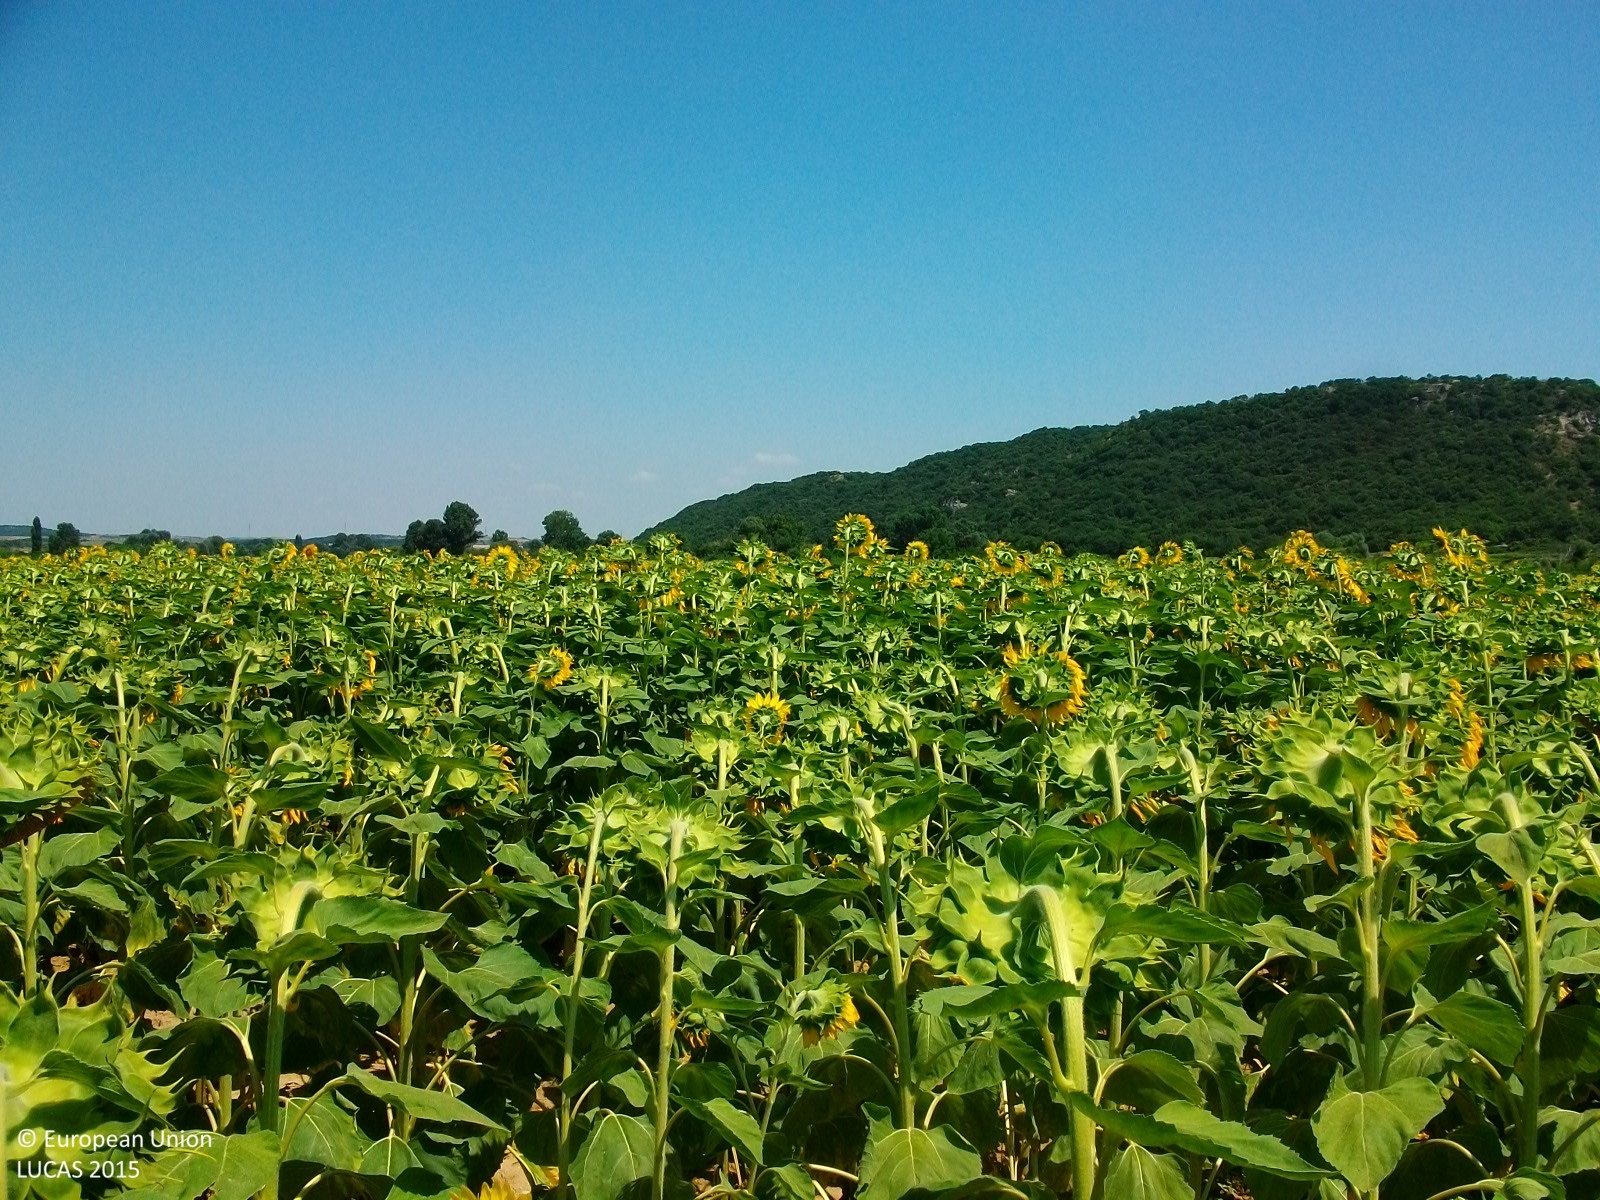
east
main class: Cropland
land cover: Sunflower
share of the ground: > 75 %
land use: Agriculture (excluding fallow land and kitchen gardens)
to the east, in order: Sunflower; Grass margins; Tracks; Abandoned hedges; Grass margins; Sunflower; Grassland without tree/shrub cover; Sunflower
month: July
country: GR
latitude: 40.9383
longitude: 26.1813
